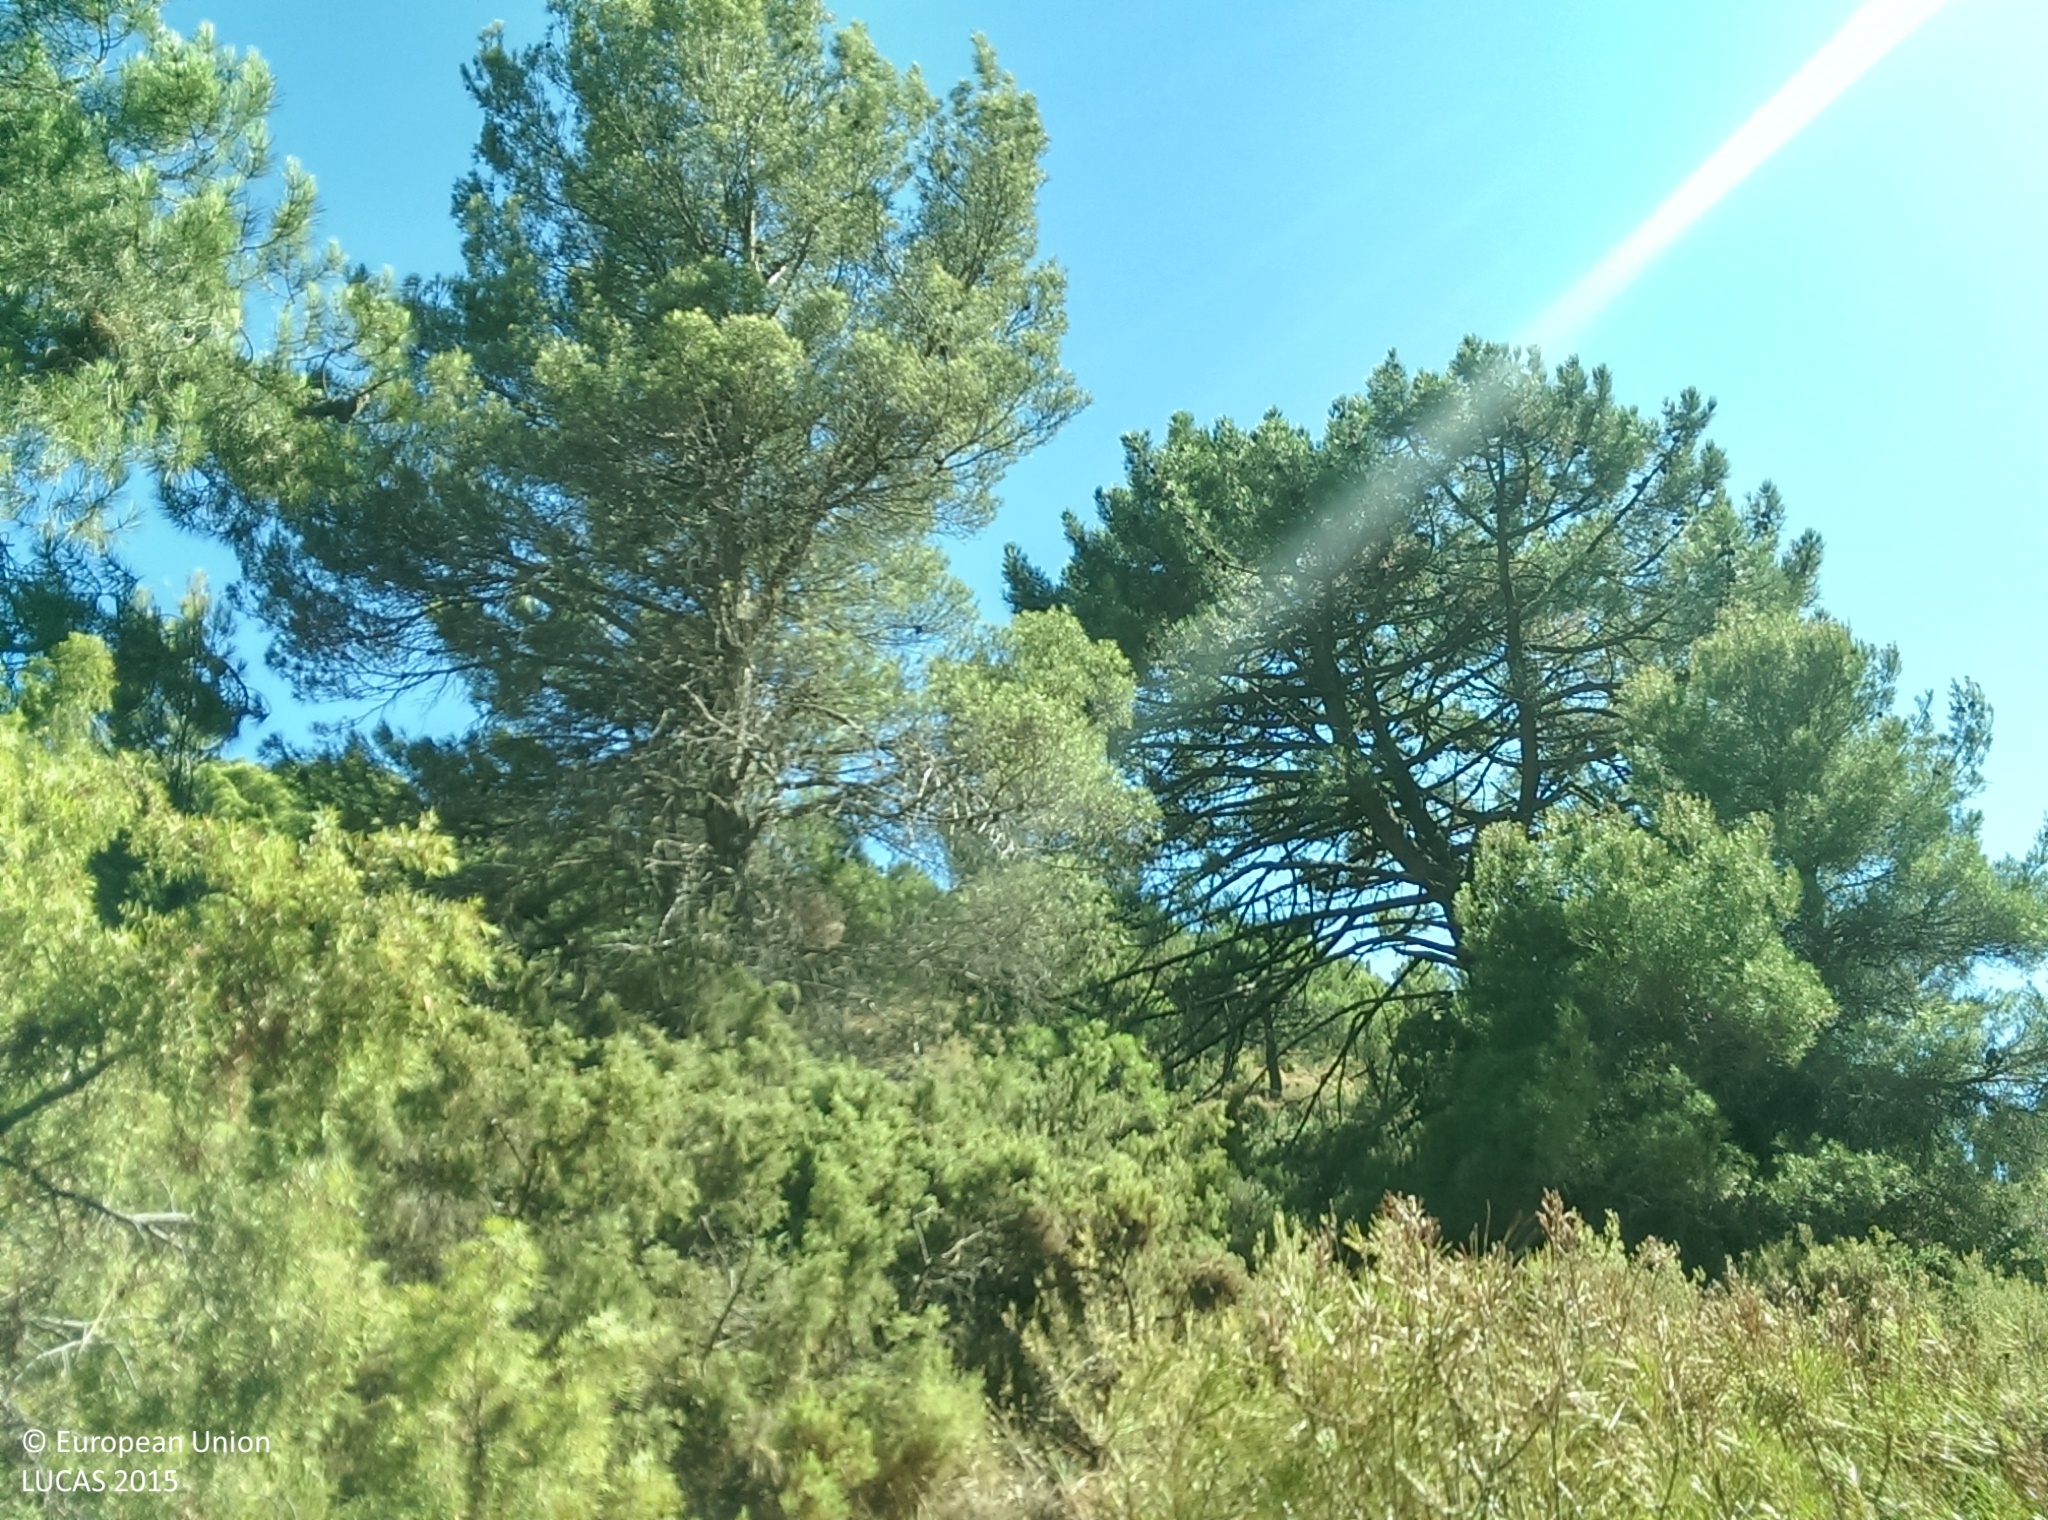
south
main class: Woodland
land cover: Pine dominated coniferous woodland
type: coniferous forest of the mediterranean region
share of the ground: 50 - 75 %
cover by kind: coniferous forest trees 65 %, shrubs 20 %, herbaceous plants 10 %, unconsolidated bare surface 5 %
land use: Forestry
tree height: > 5 m
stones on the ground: > 50 %
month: August
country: ES
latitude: 36.8946
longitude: -3.5963
